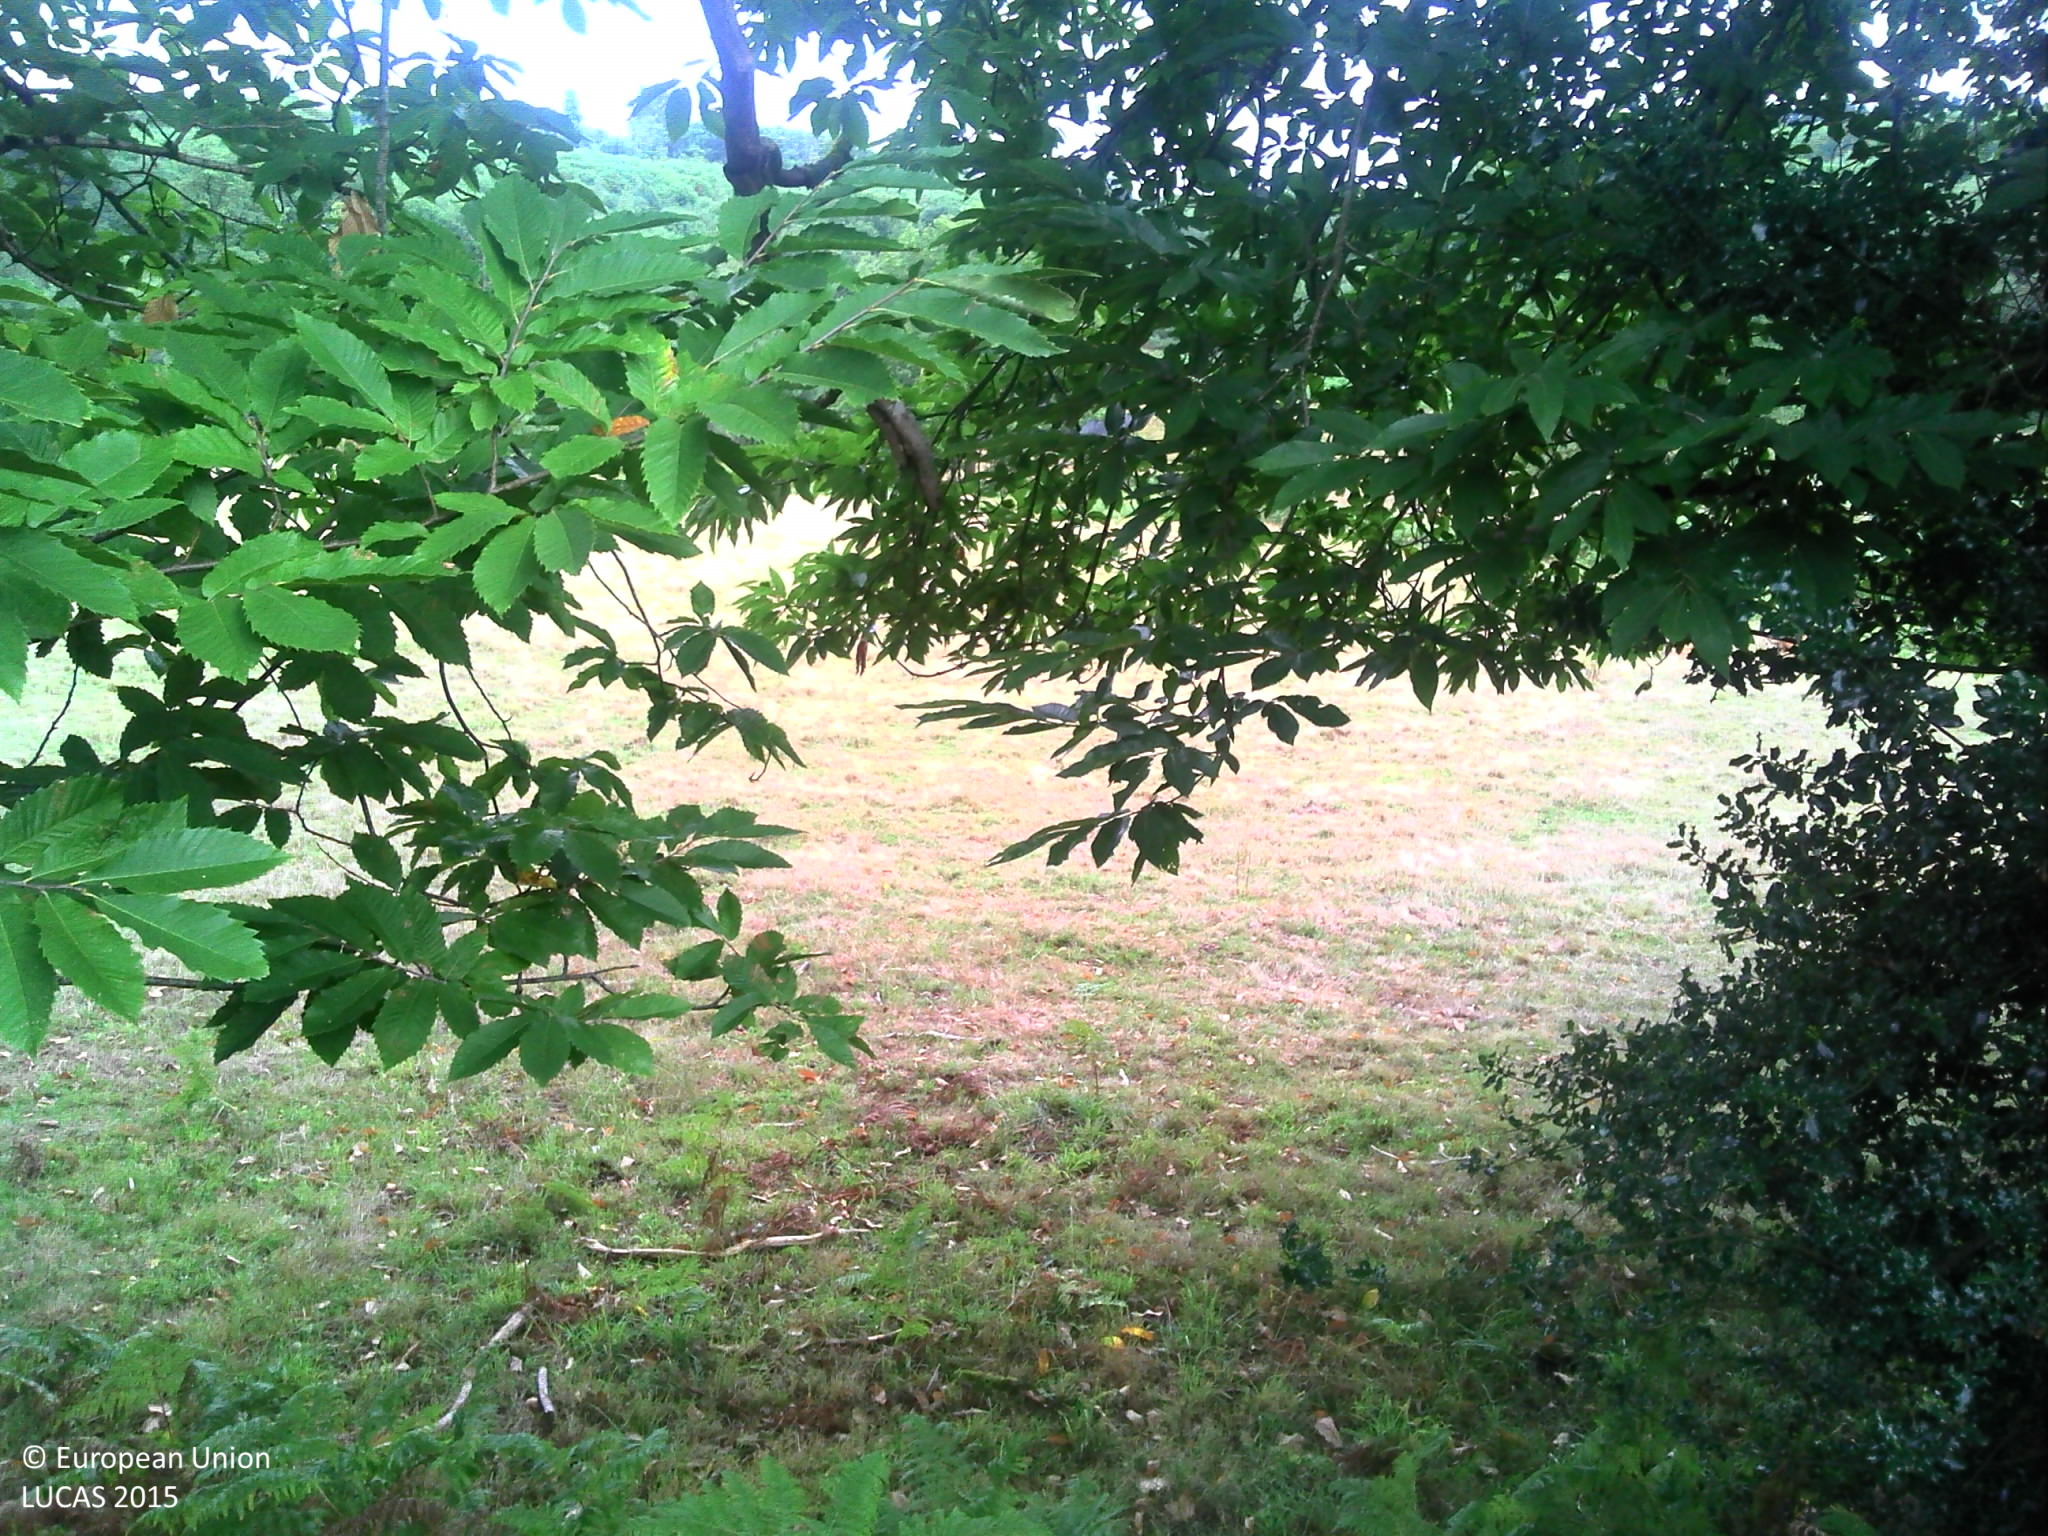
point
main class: Grassland
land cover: Grassland without tree/shrub cover
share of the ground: > 75 %
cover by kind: herbaceous plants 100 %
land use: Agriculture (excluding fallow land and kitchen gardens)
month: August
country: FR
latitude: 46.0220
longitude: 0.9586
